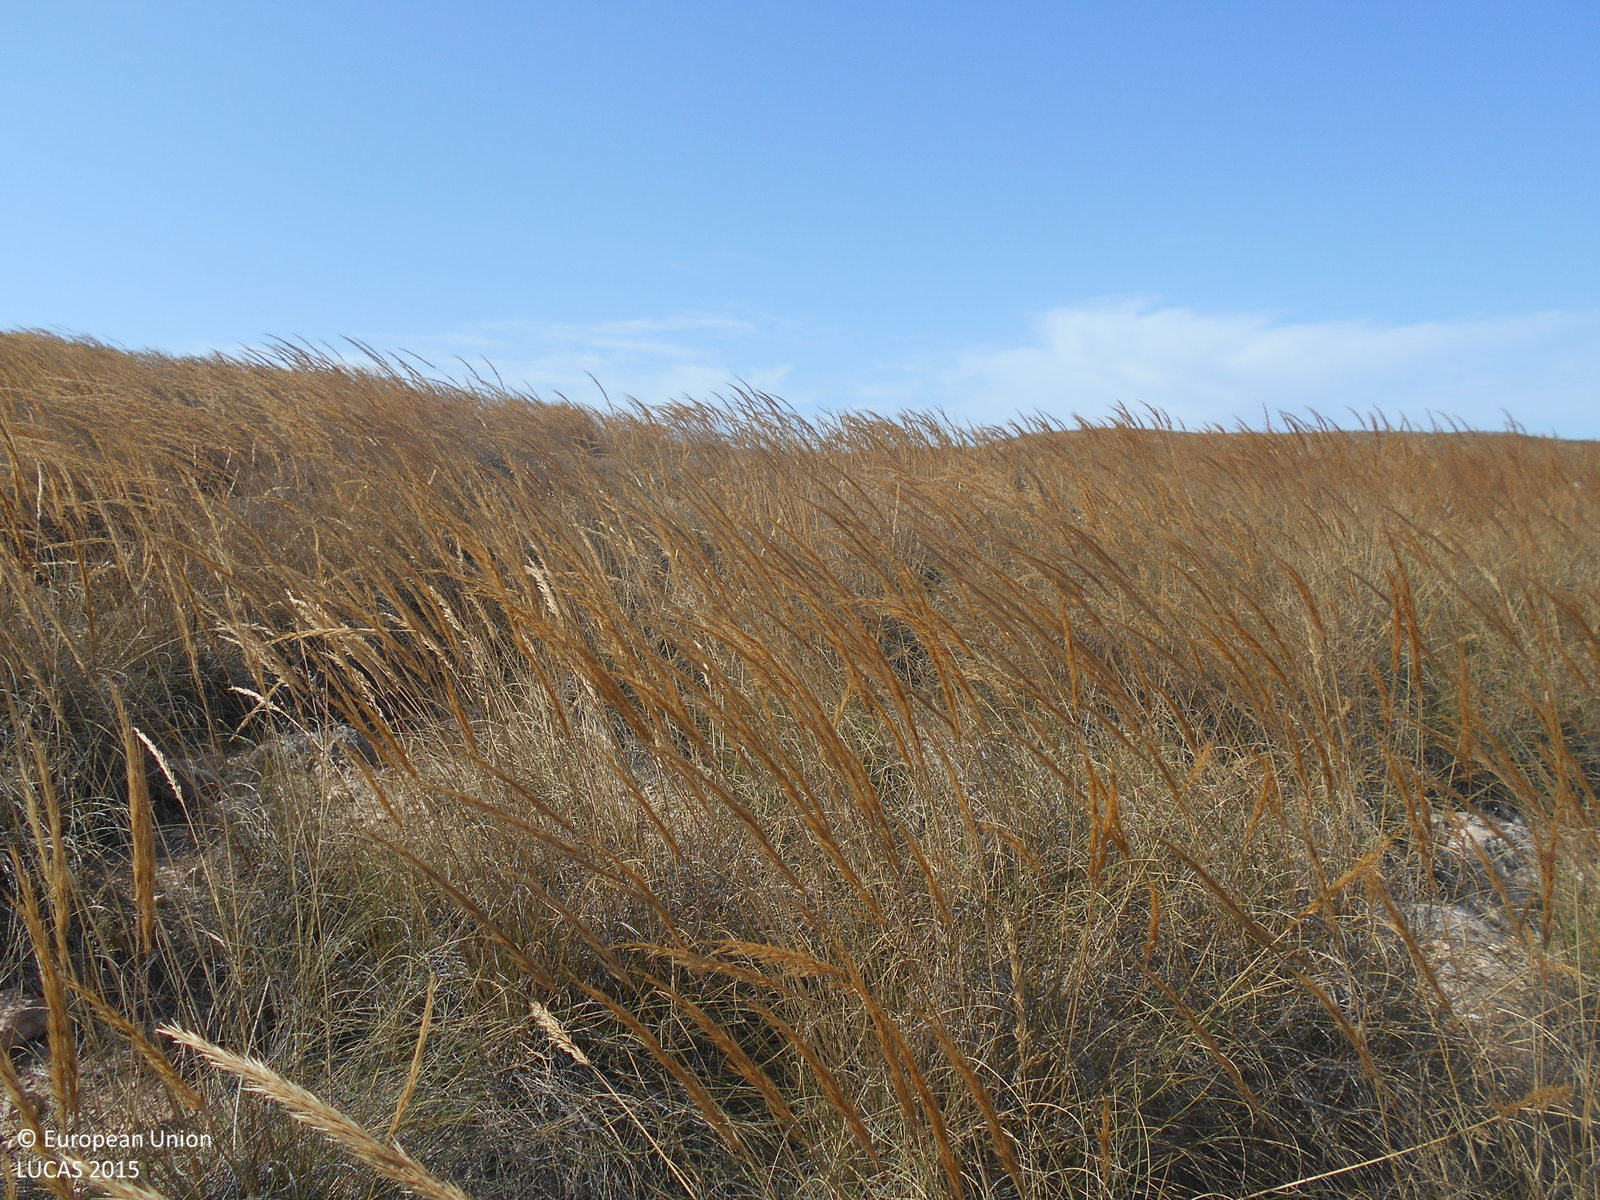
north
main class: Shrubland
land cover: Shrubland without tree cover
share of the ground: 25 - 50 %
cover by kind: shrubs 40 %, unconsolidated bare surface 30 %, consolidated bare surface 20 %, herbaceous plants 10 %
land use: Semi-natural and natural areas not in use
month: May
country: ES
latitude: 36.8269
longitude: -2.2279
